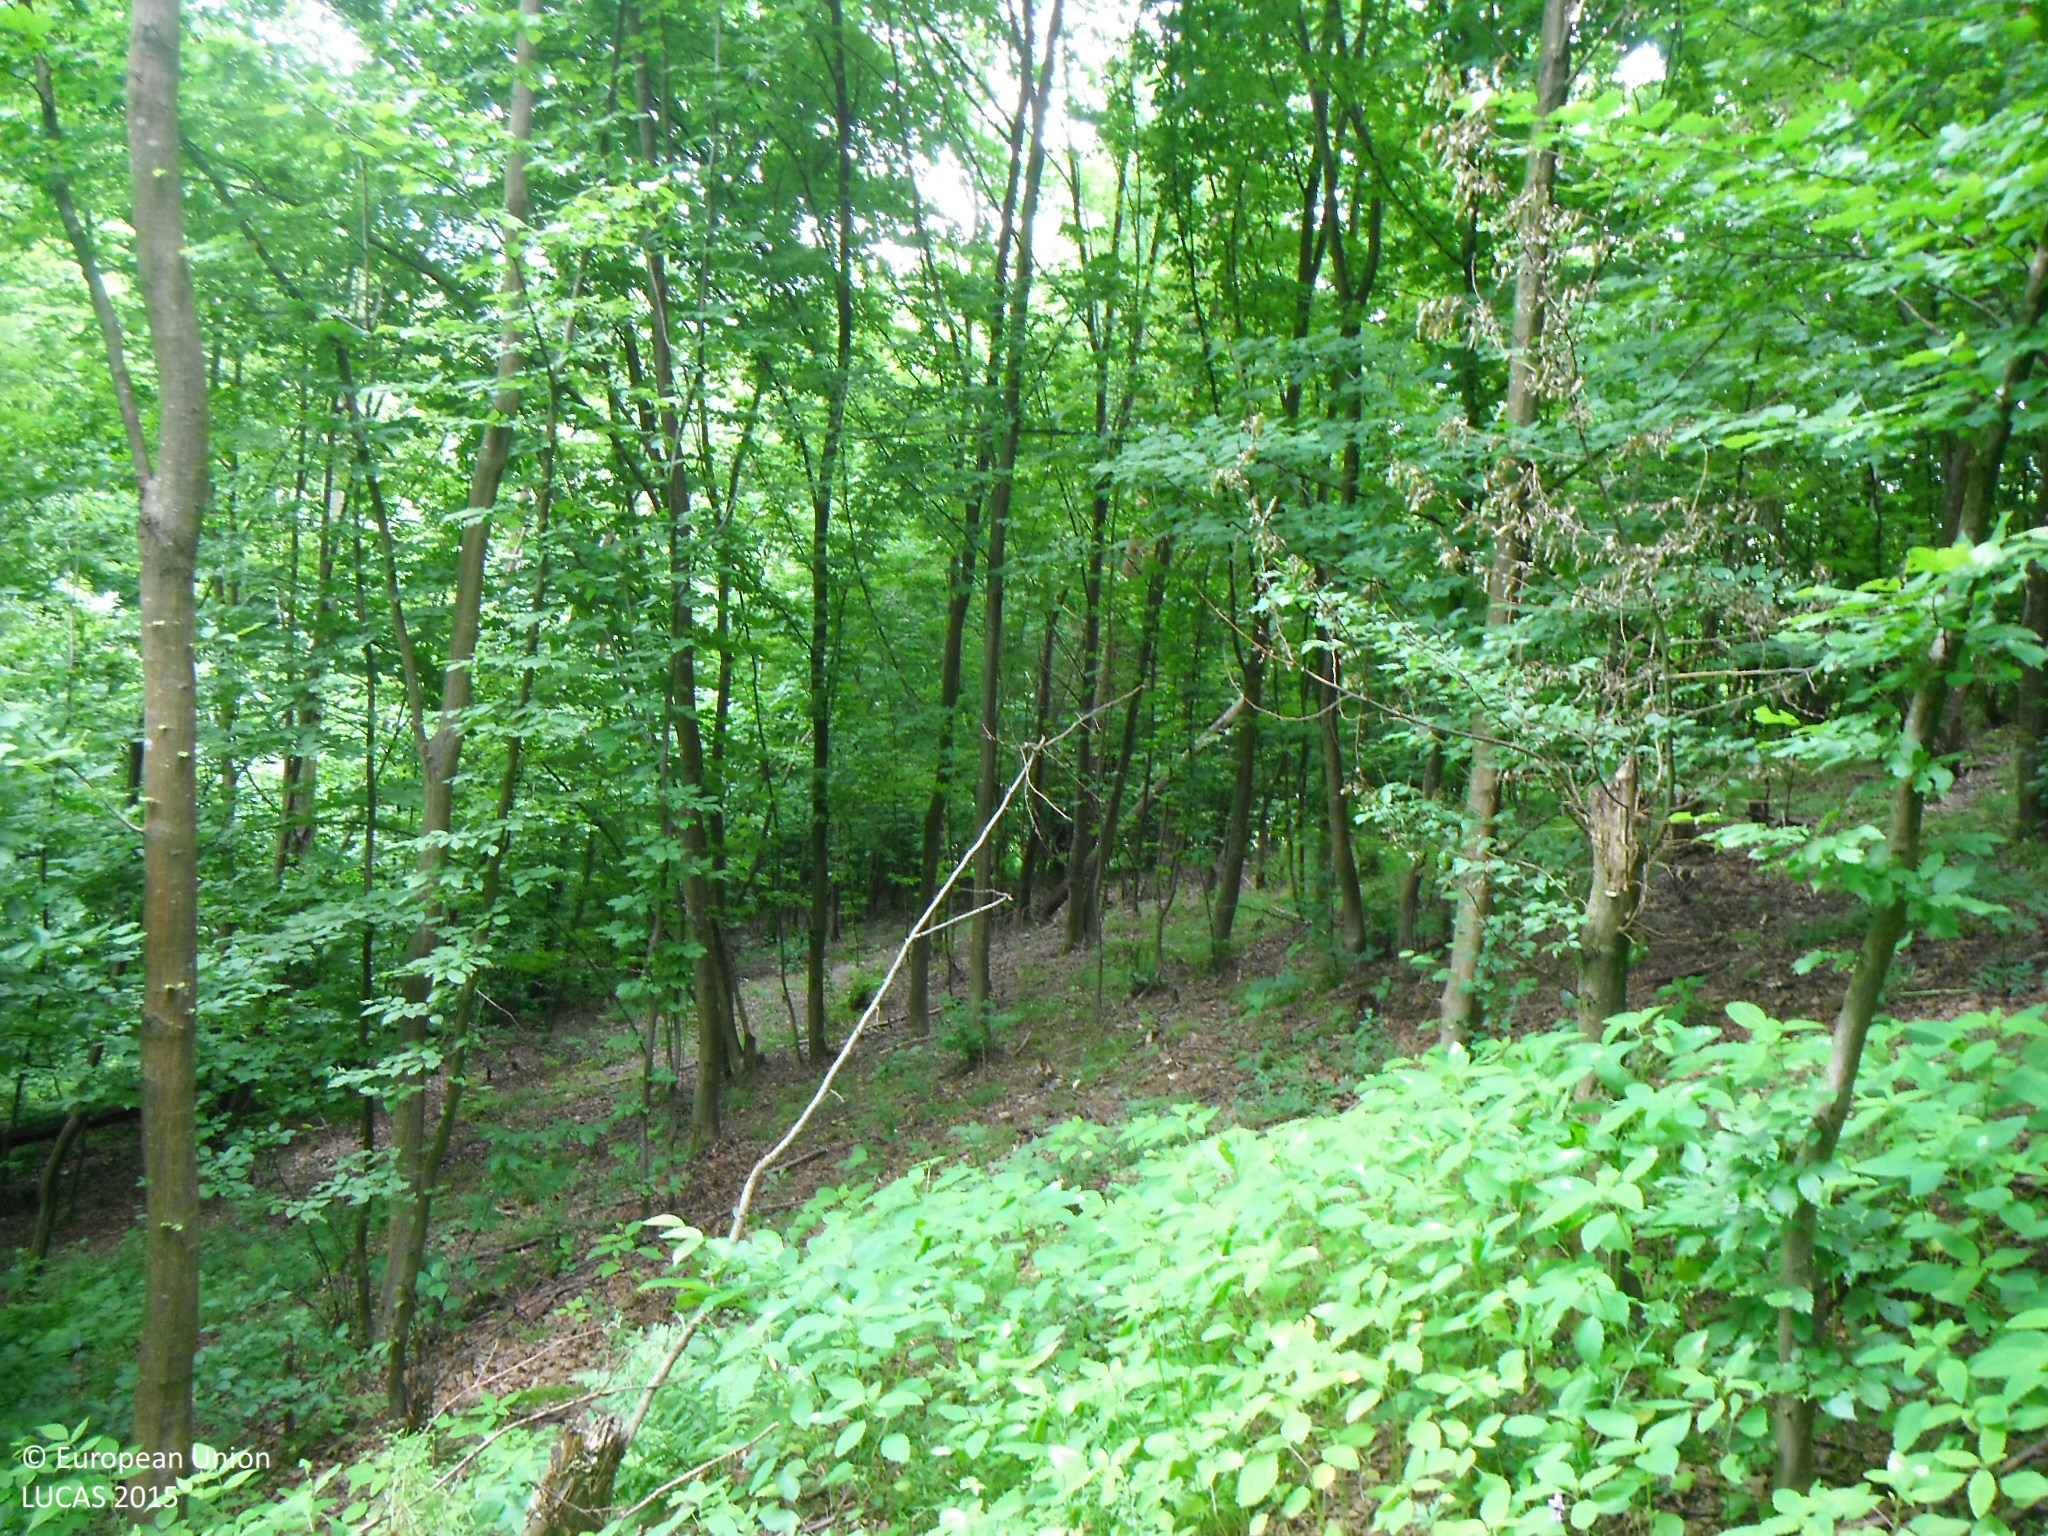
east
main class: Woodland
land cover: Broadleaved woodland
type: mesophytic deciduous forest
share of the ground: > 75 %
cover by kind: broadleaved forest trees 90 %, herbaceous plants 10 %
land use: Forestry
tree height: > 5 m
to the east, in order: Broadleaved woodland; Grassland without tree/shrub cover; Broadleaved woodland; Grassland without tree/shrub cover; Fences; Spontaneously vegetated surfaces; Artificial constructions in urban areas; Rivers and streams; Artificial constructions in urban areas
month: June
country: SK
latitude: 48.6246
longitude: 19.9468
